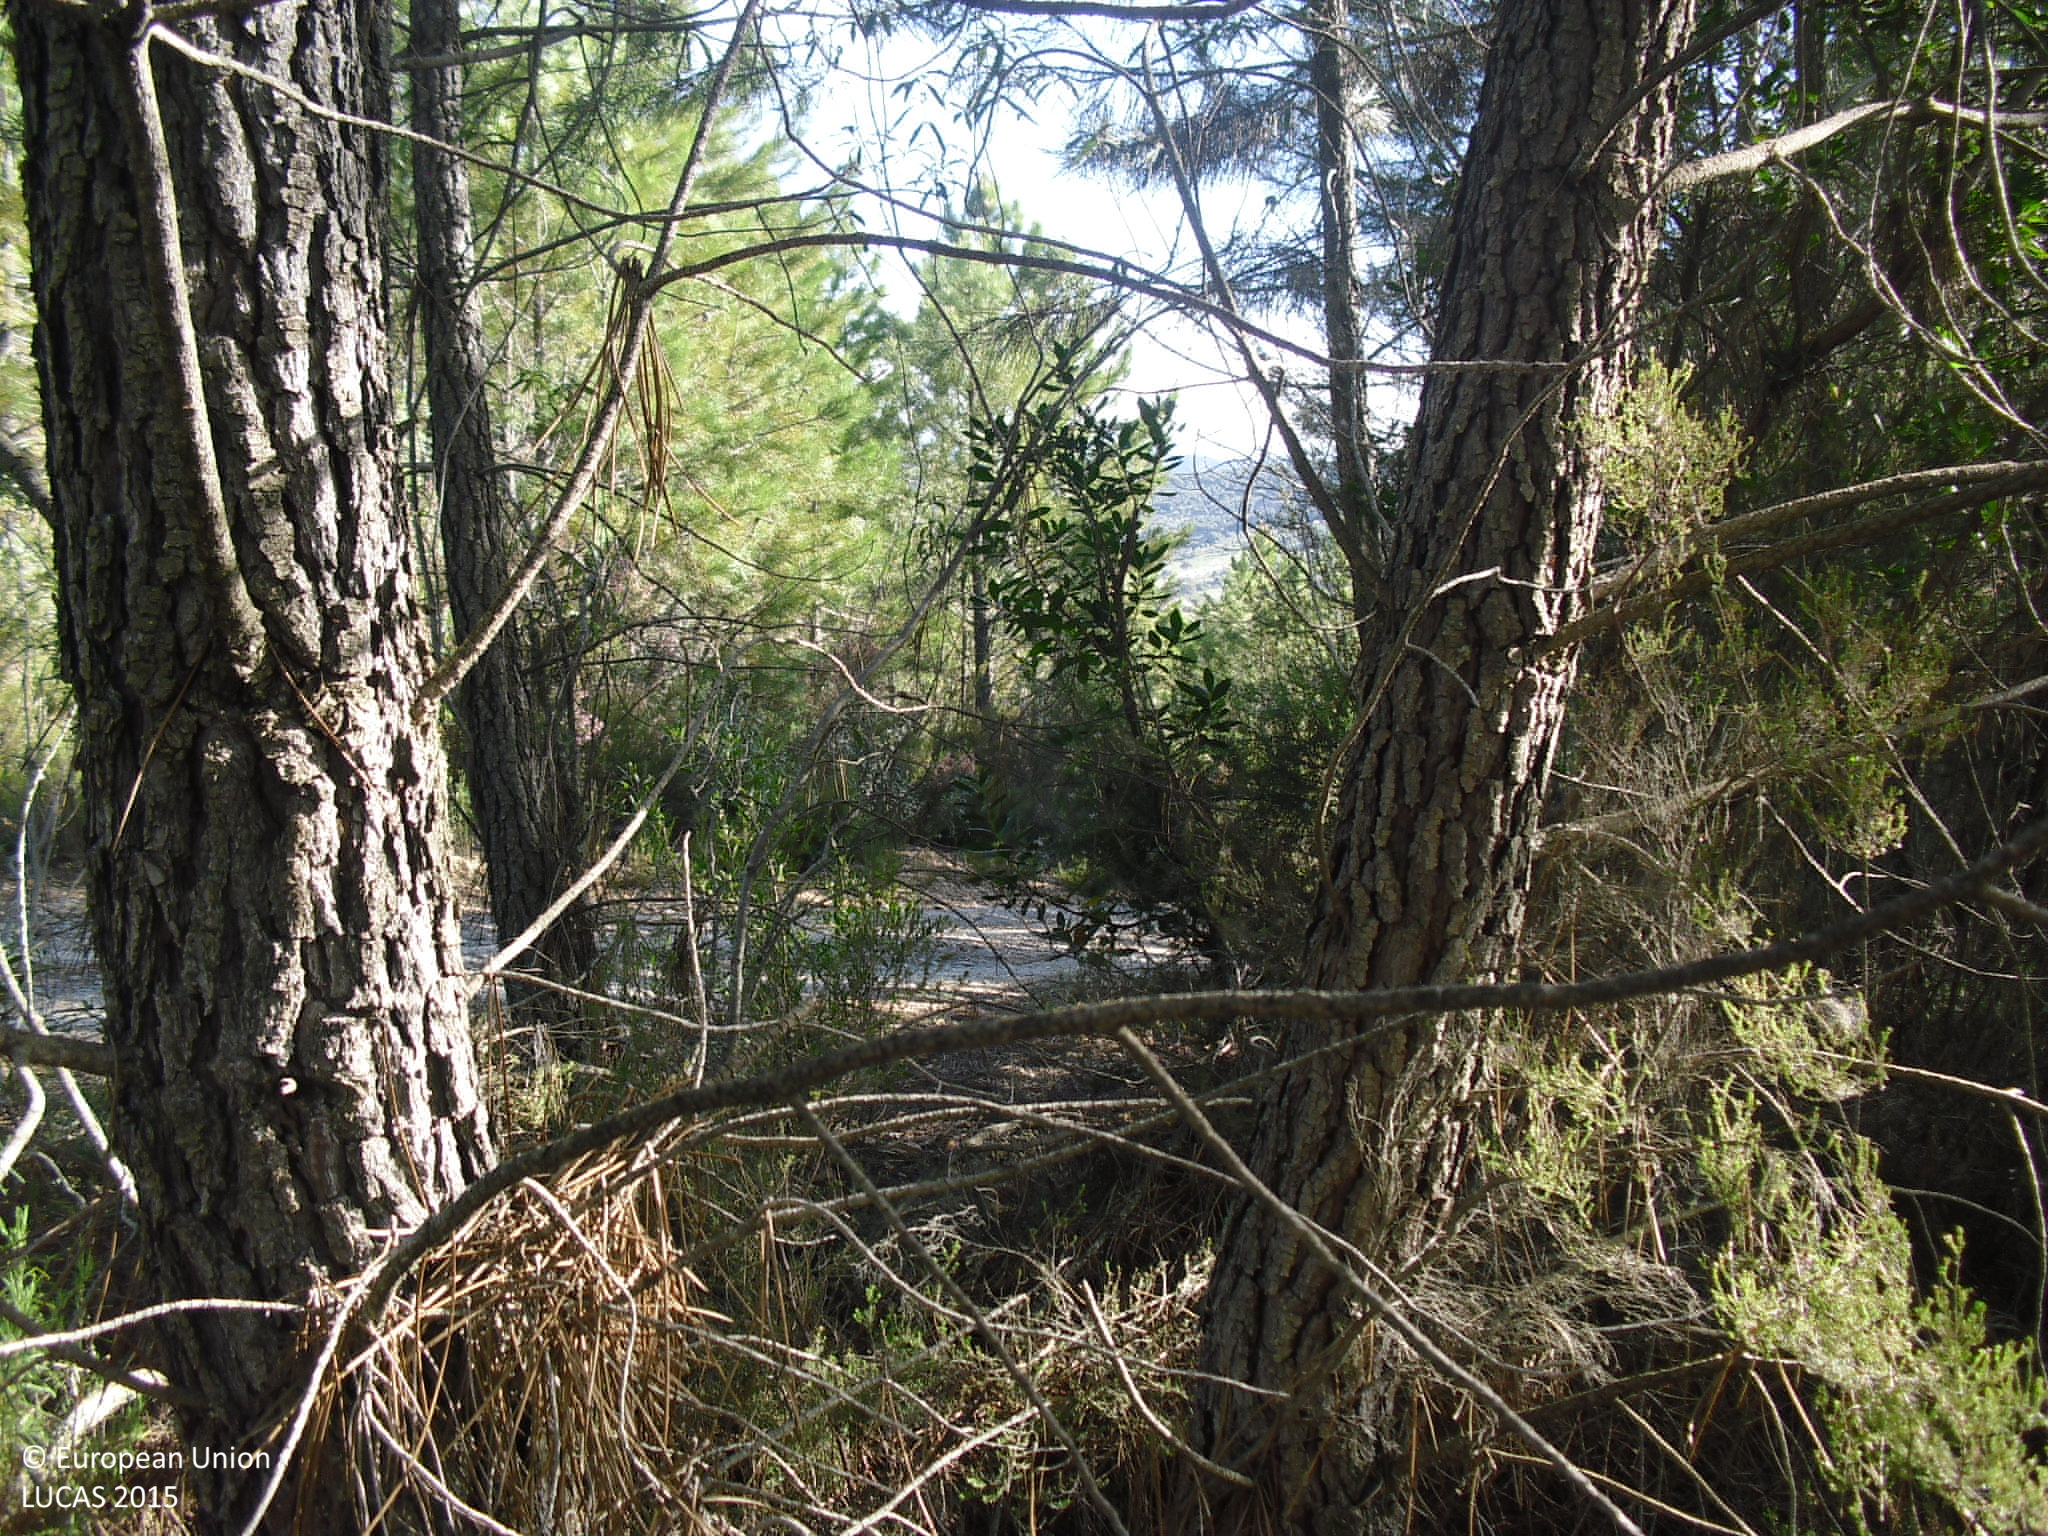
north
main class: Woodland
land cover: Pine dominated coniferous woodland
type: coniferous forest of the mediterranean region
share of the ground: > 75 %
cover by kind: coniferous forest trees 100 %
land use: Forestry
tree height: > 5 m
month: April
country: ES
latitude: 39.4941
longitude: -5.3398
